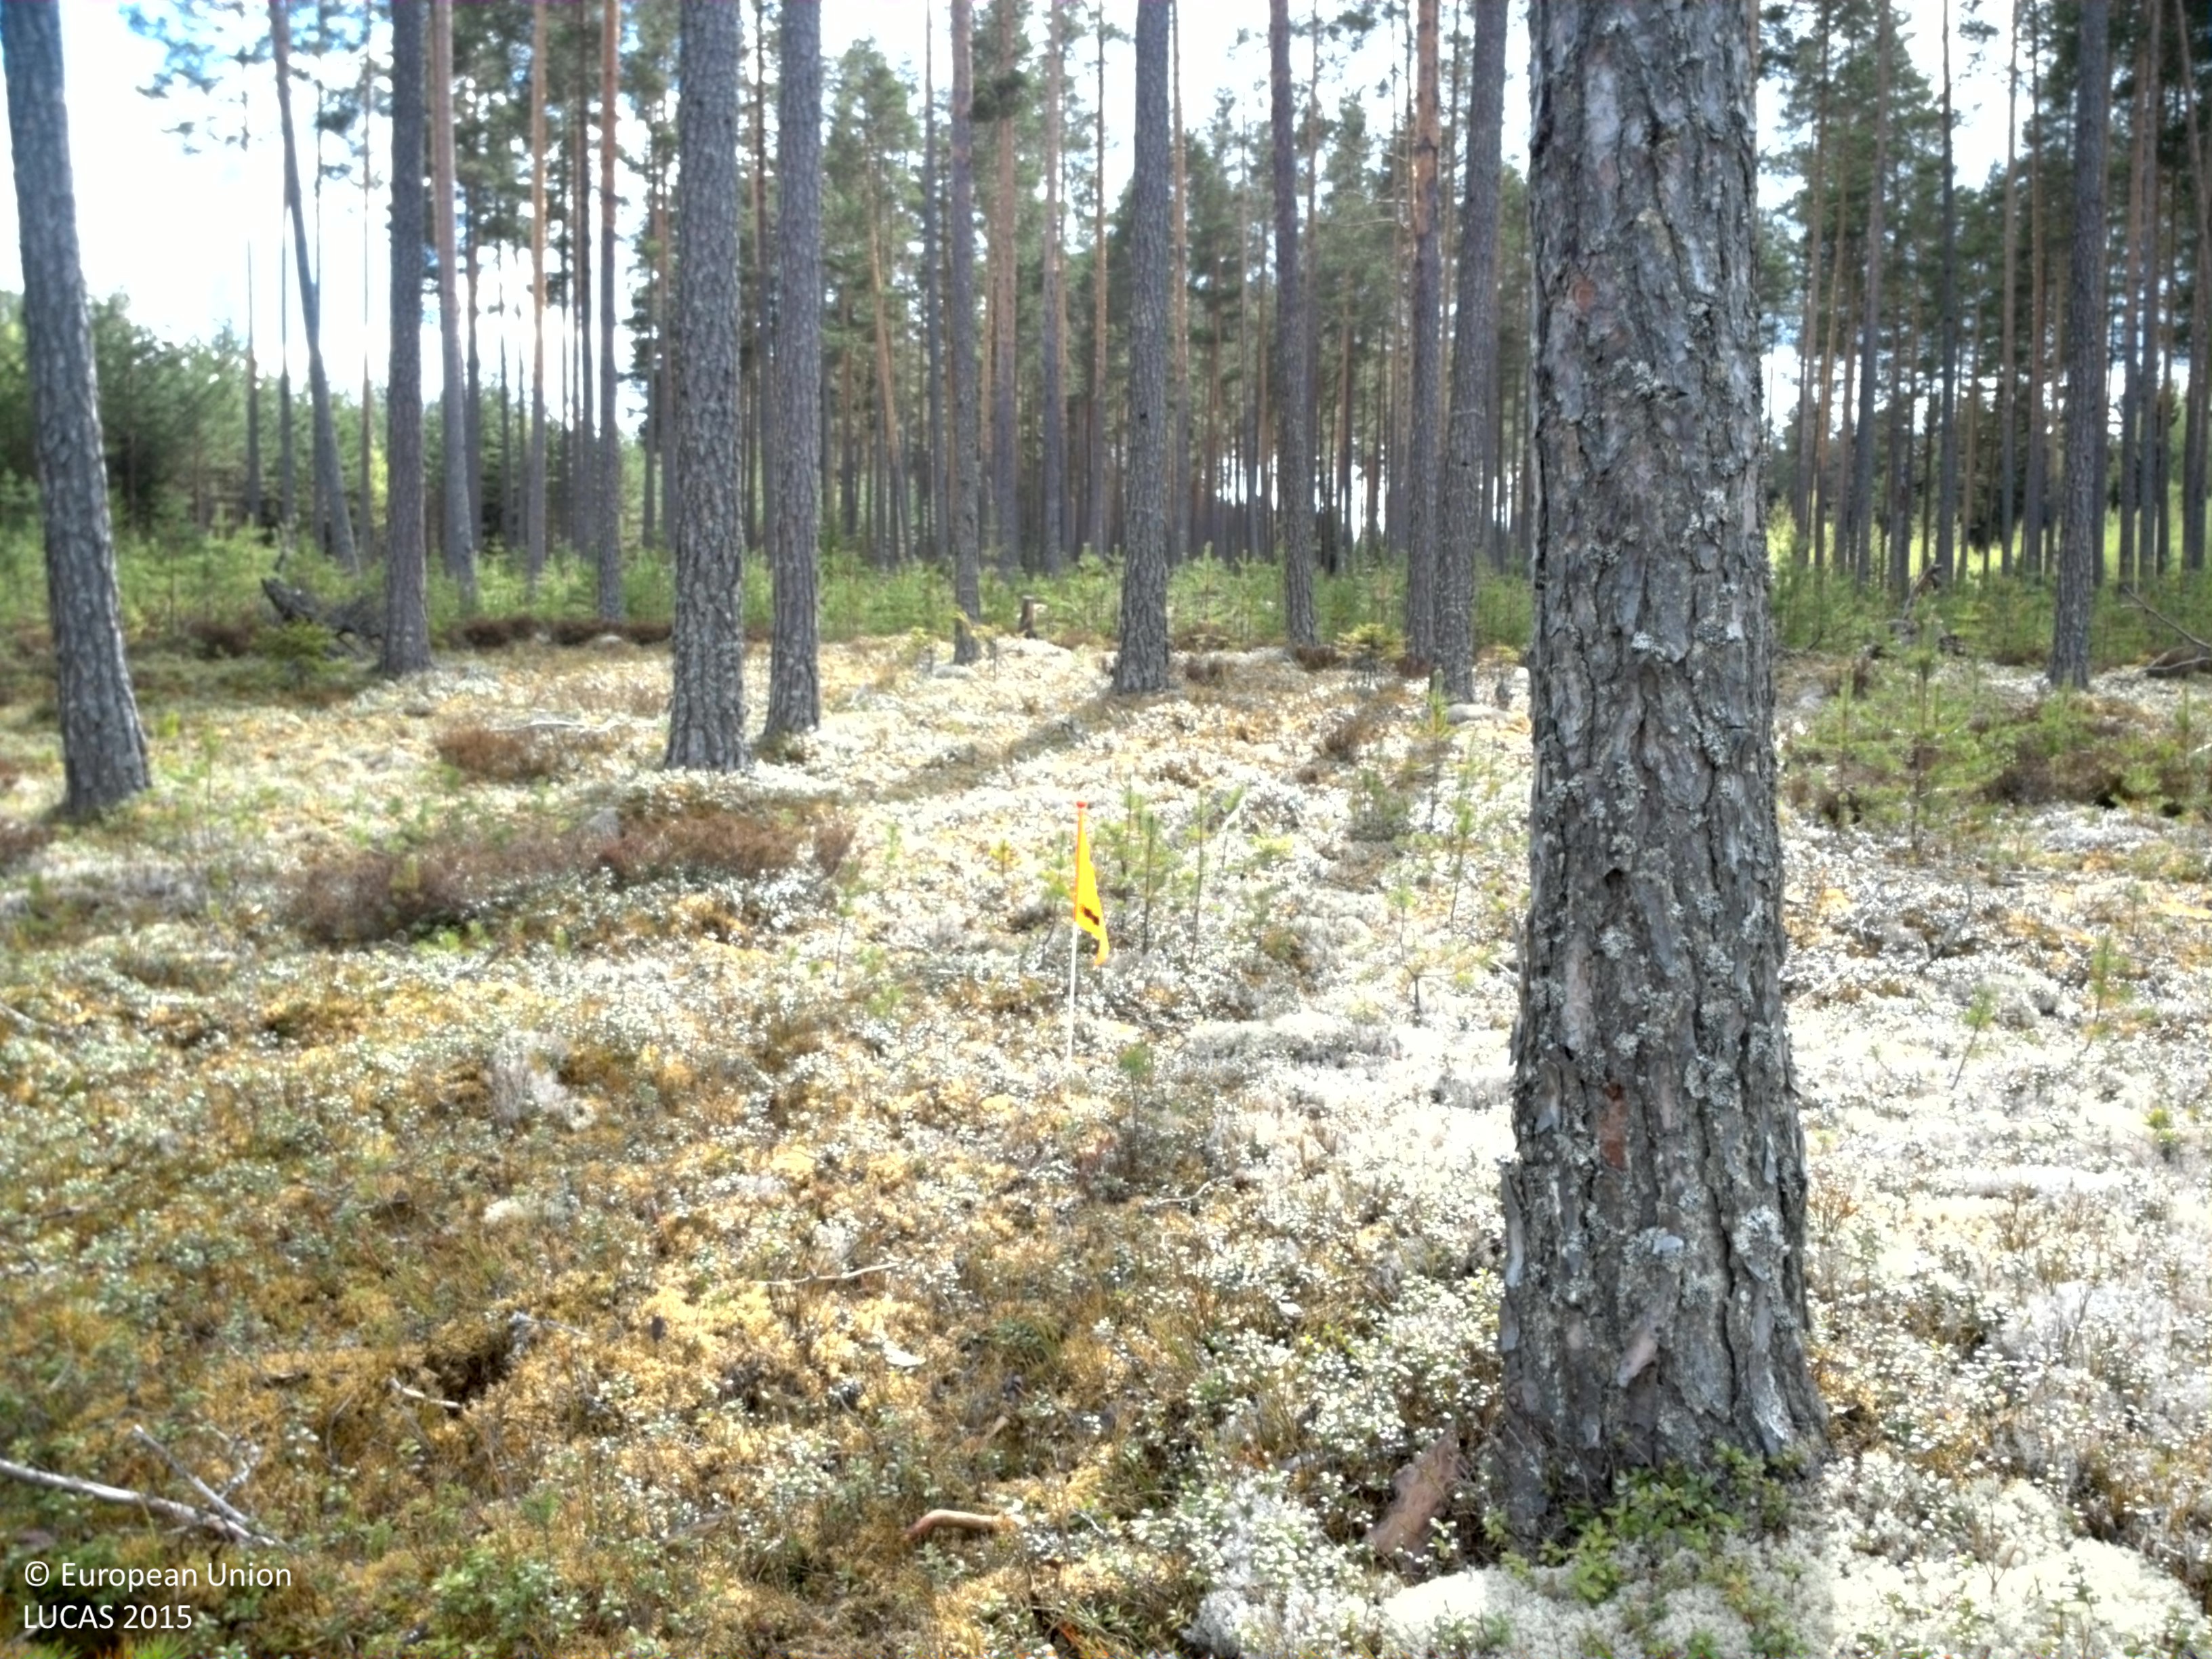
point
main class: Woodland
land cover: Pine dominated coniferous woodland
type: boreal forest
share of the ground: 25 - 50 %
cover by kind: coniferous forest trees 35 %, shrubs 25 %, herbaceous plants 20 %, lichens and mosses 20 %
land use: Forestry
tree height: > 5 m
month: May
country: SE
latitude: 61.1727
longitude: 15.0610
